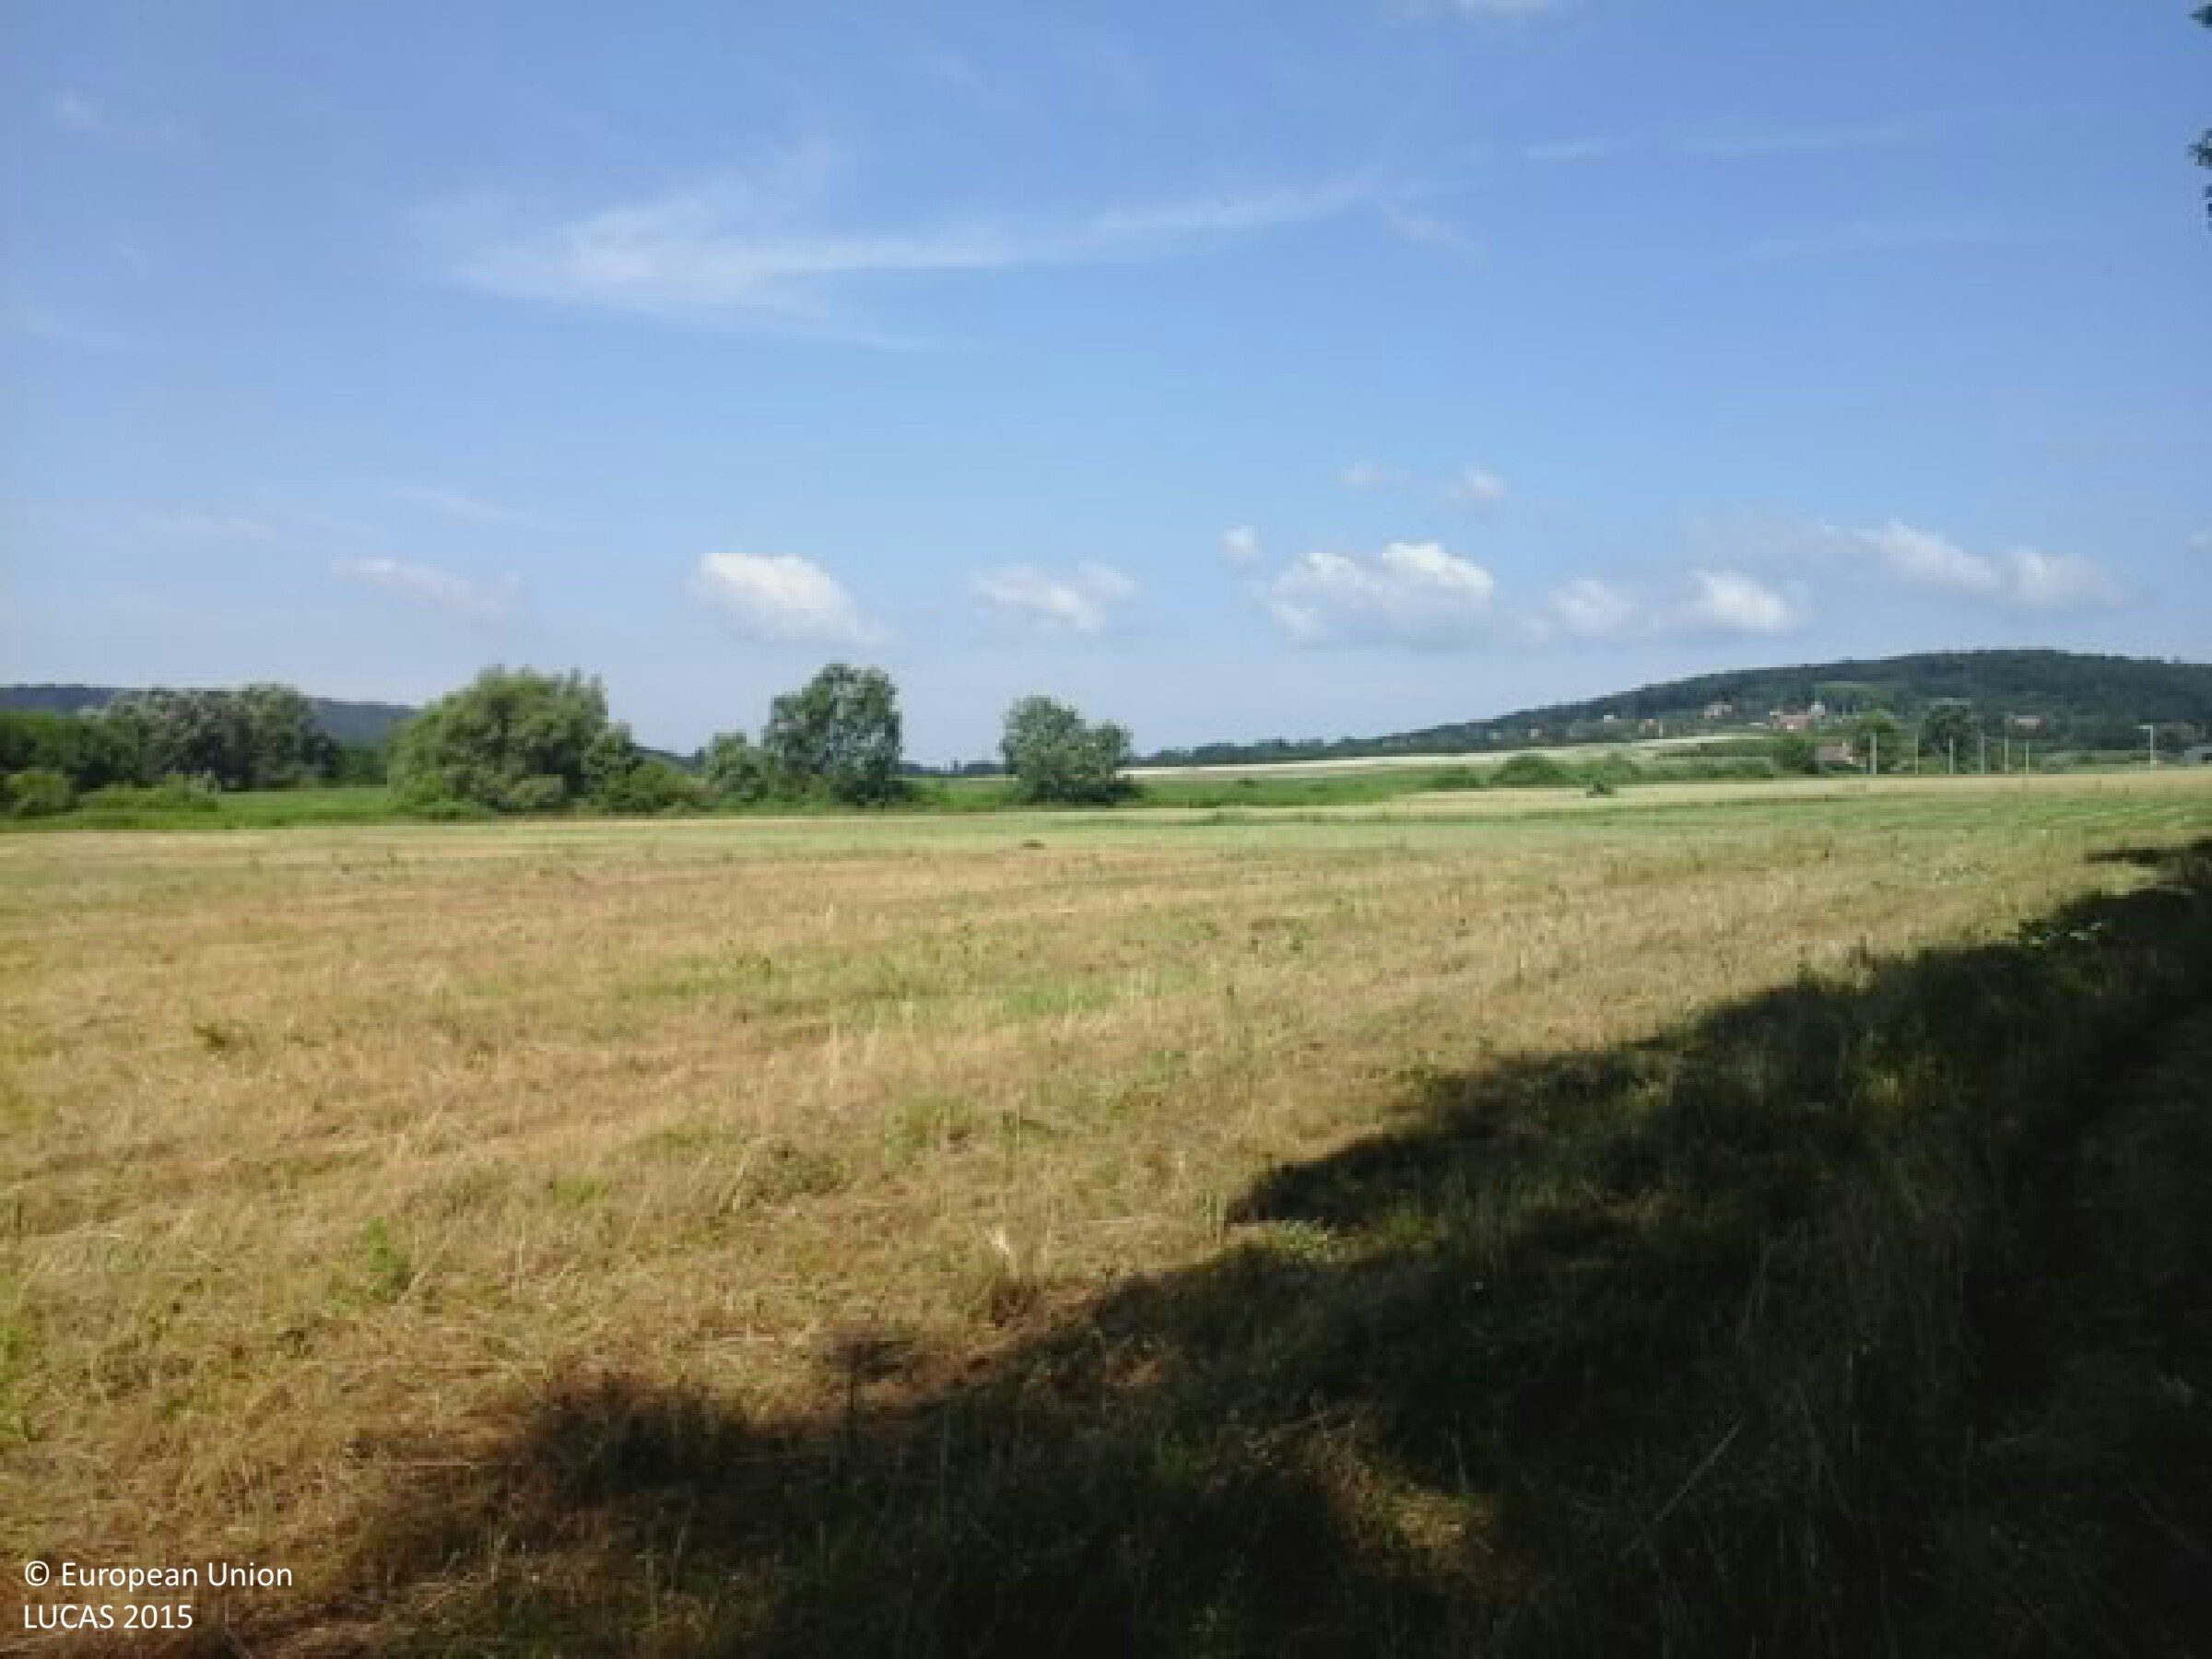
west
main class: Woodland
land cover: Broadleaved woodland
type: exotic forest
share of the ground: > 75 %
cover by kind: broadleaved forest trees 90 %, shrubs 10 %
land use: Forestry
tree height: > 5 m
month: June
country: HU
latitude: 47.6353
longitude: 19.2432
